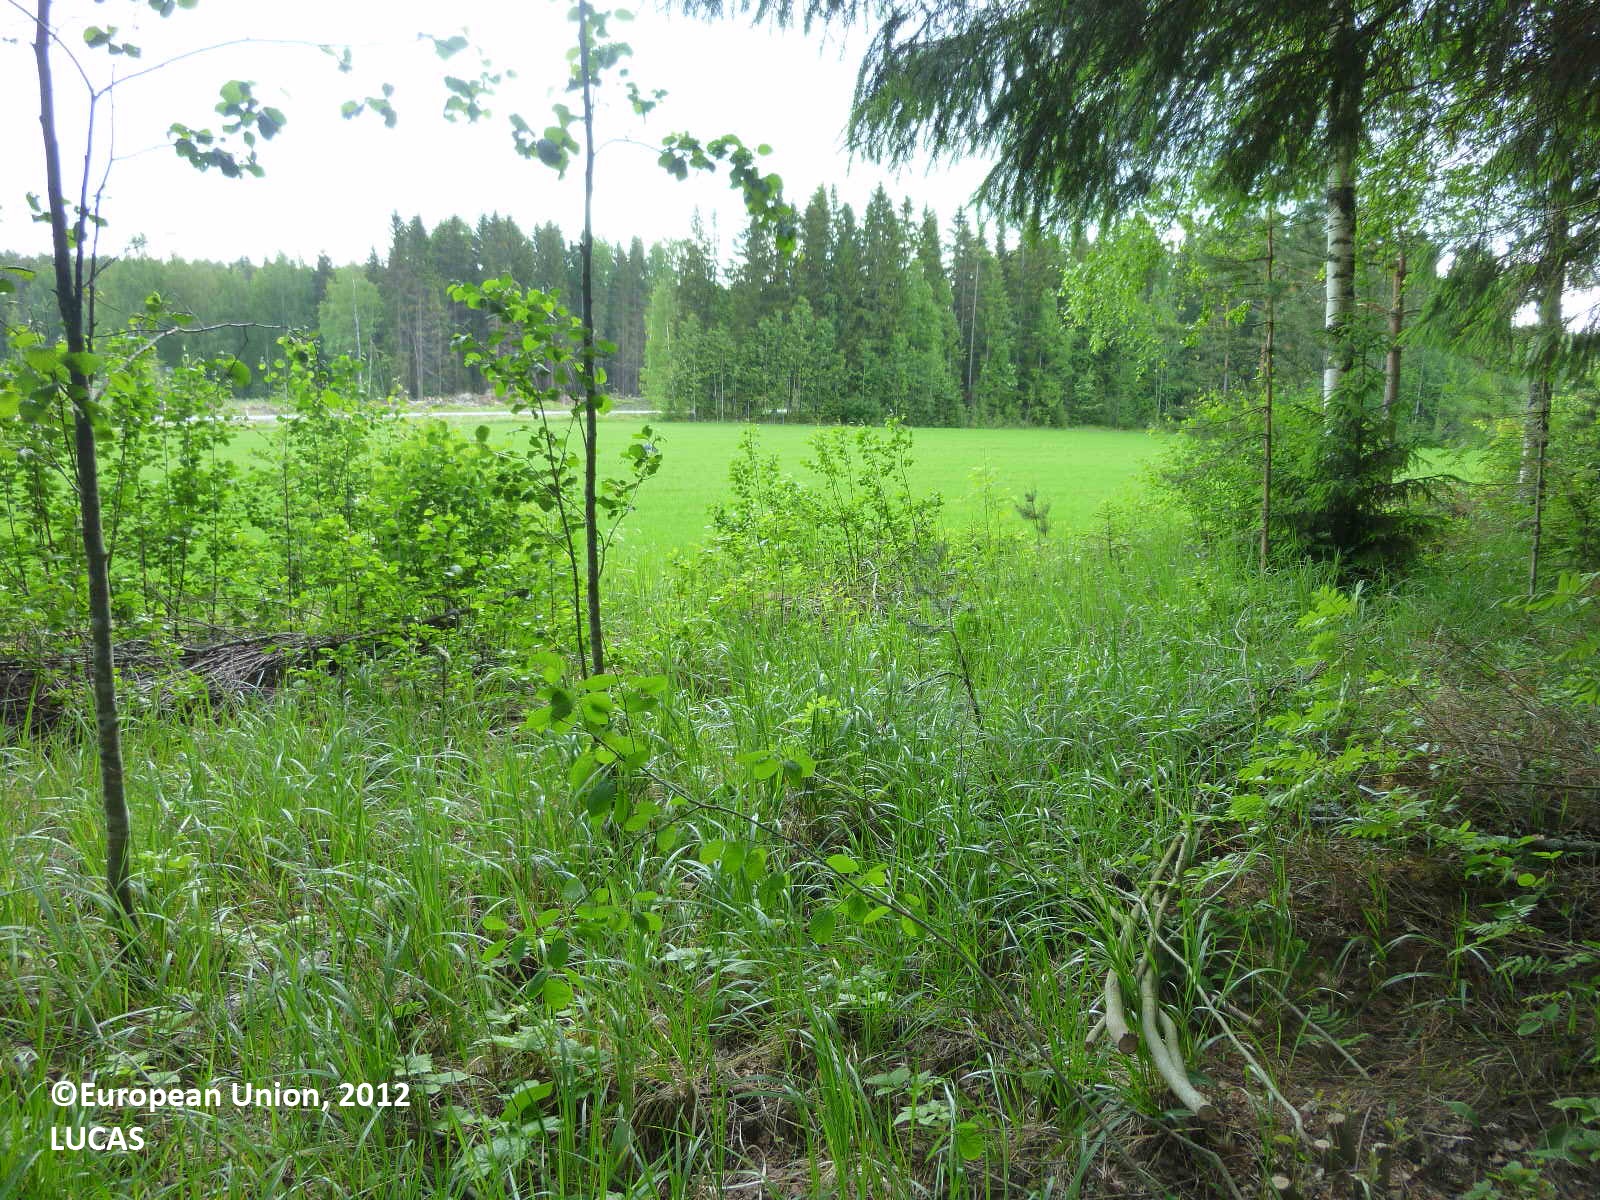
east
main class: Woodland
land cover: Spruce dominated coniferous woodland
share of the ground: > 75 %
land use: Forestry
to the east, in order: Spruce dominated coniferous woodland; Ditches and canals; Grass margins; Barley; Grass margins; Paved roads, cycling and walking lanes; Grass margins; Ditches and canals; Grass margins; Other bare soil; Spruce dominated mixed woodland; Broadleaved woodland; Ditches and canals; Other bare soil
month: June
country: FI
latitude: 61.3977
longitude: 22.6688
